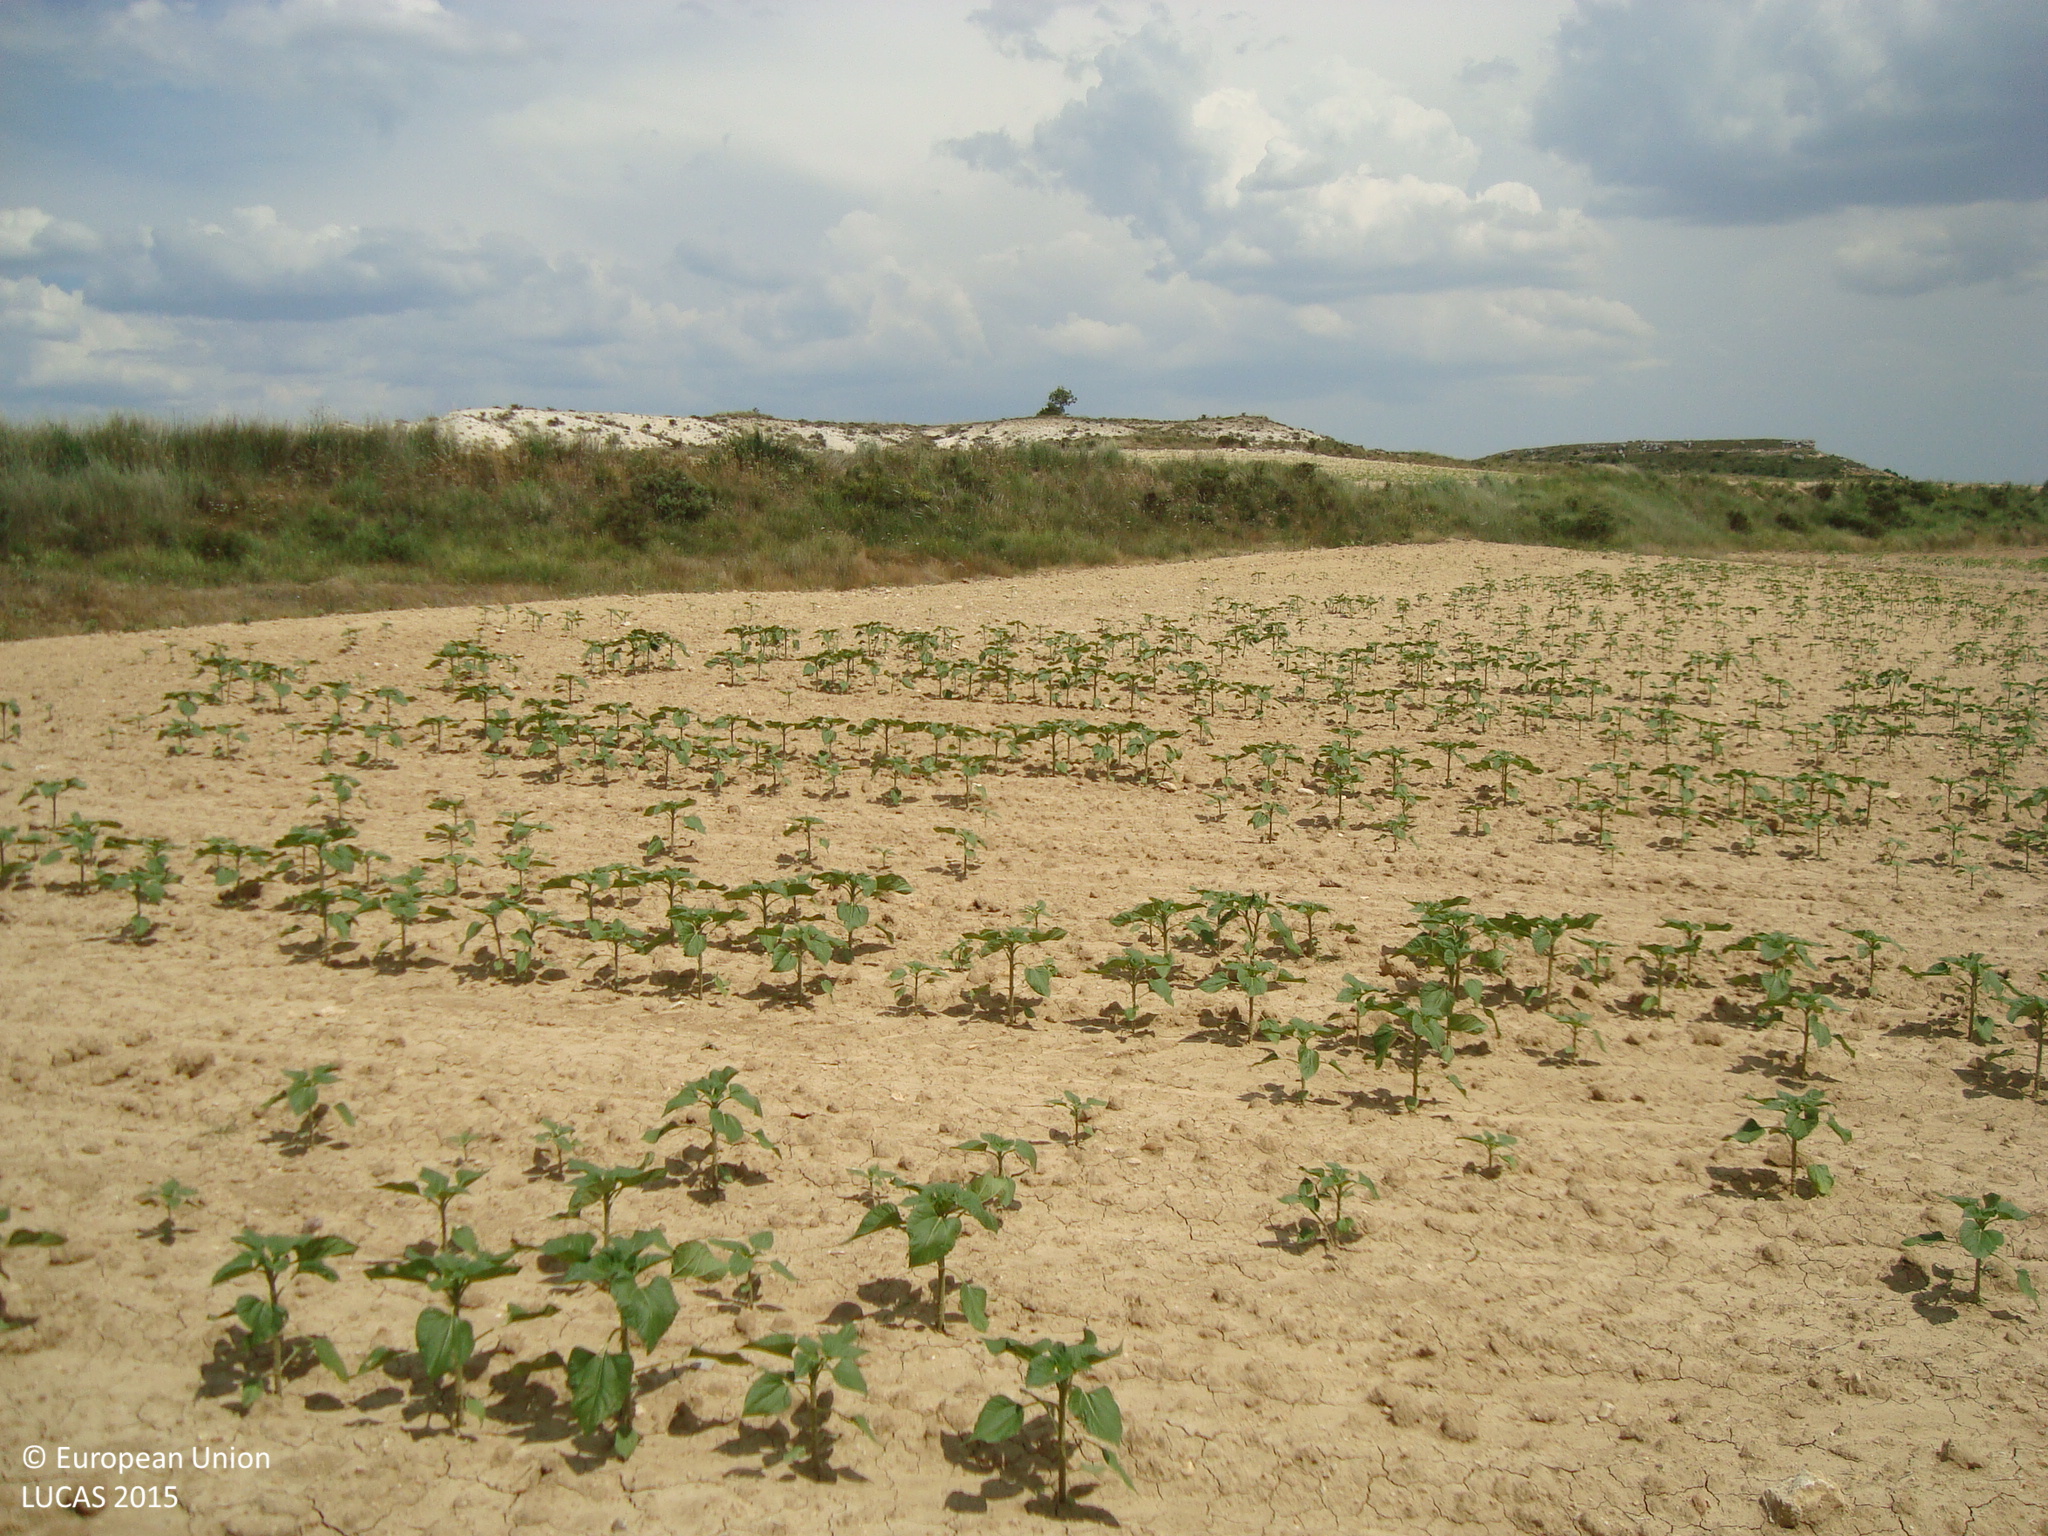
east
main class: Cropland
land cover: Sunflower
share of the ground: < 10 %
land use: Agriculture (excluding fallow land and kitchen gardens)
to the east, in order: Sunflower; Grassland without tree/shrub cover; Rape and turnip rape; Other bare soil; Sunflower
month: June
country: ES
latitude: 41.8769
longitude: -3.6098
